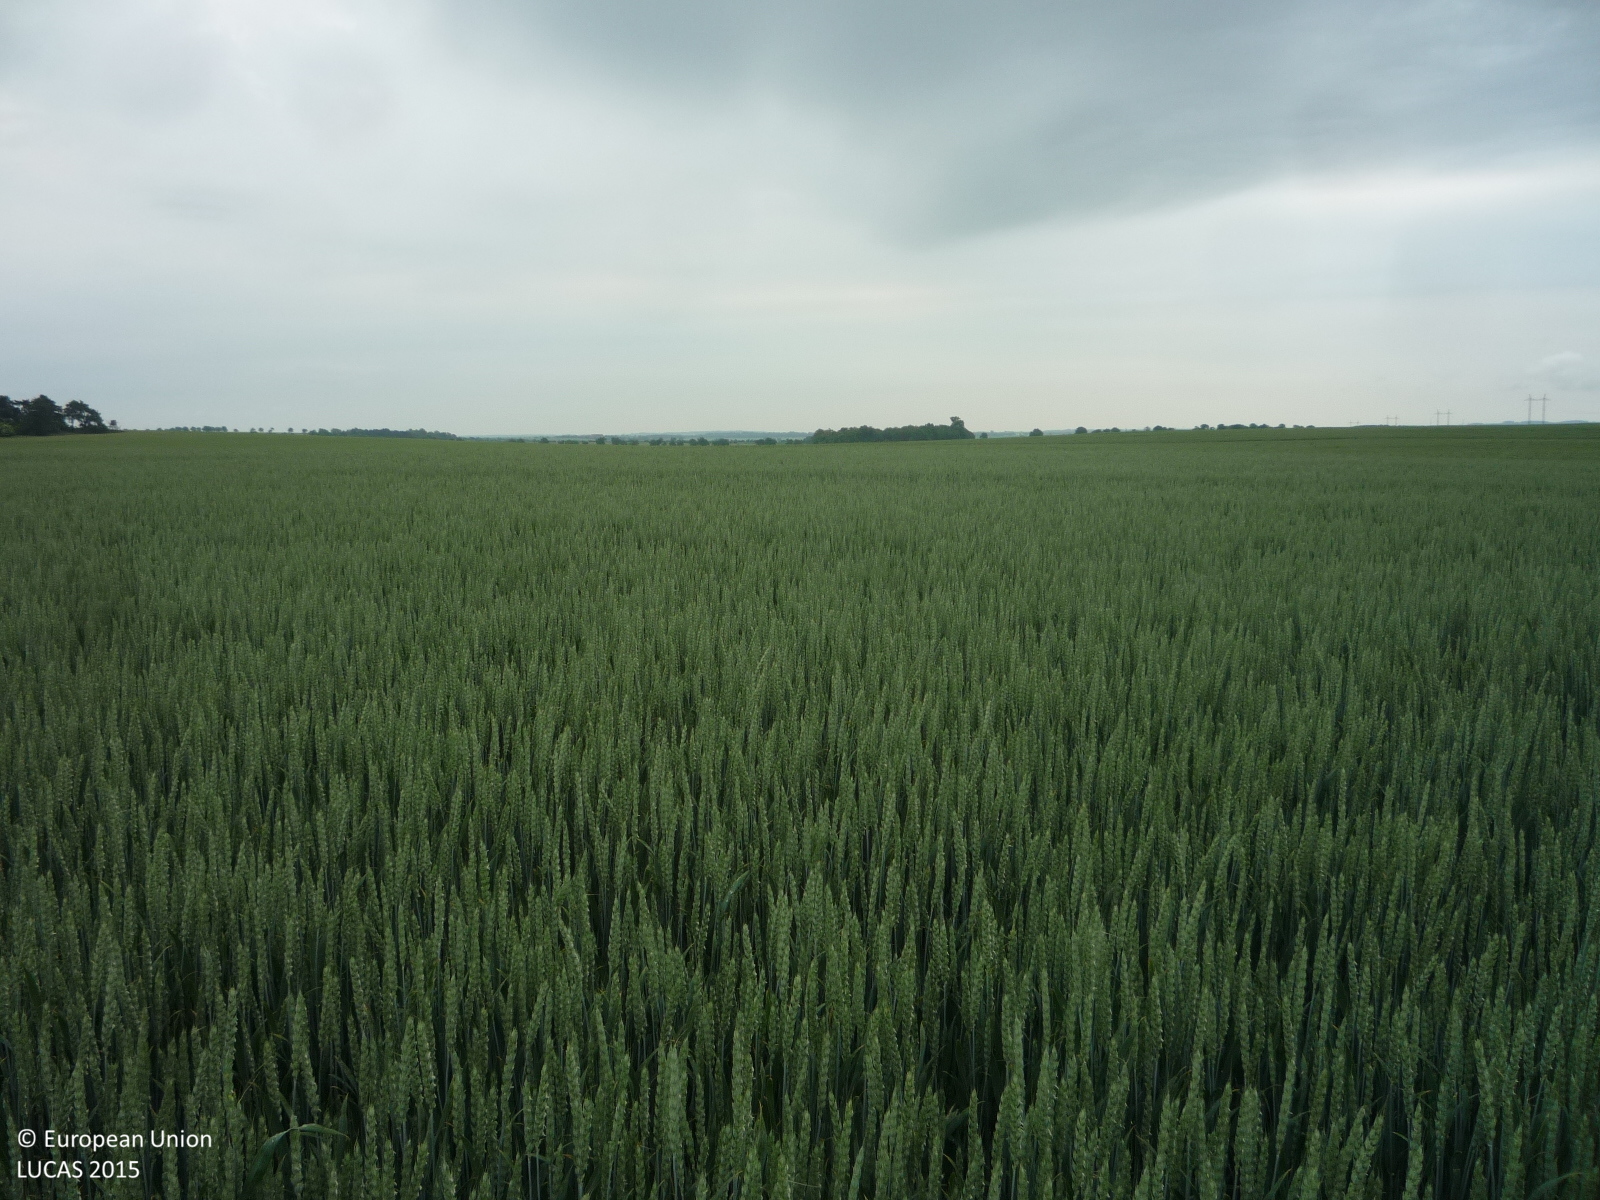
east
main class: Cropland
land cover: Common wheat
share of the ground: > 75 %
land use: Agriculture (excluding fallow land and kitchen gardens)
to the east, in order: Common wheat
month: June
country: CZ
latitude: 50.3260
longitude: 14.1168
